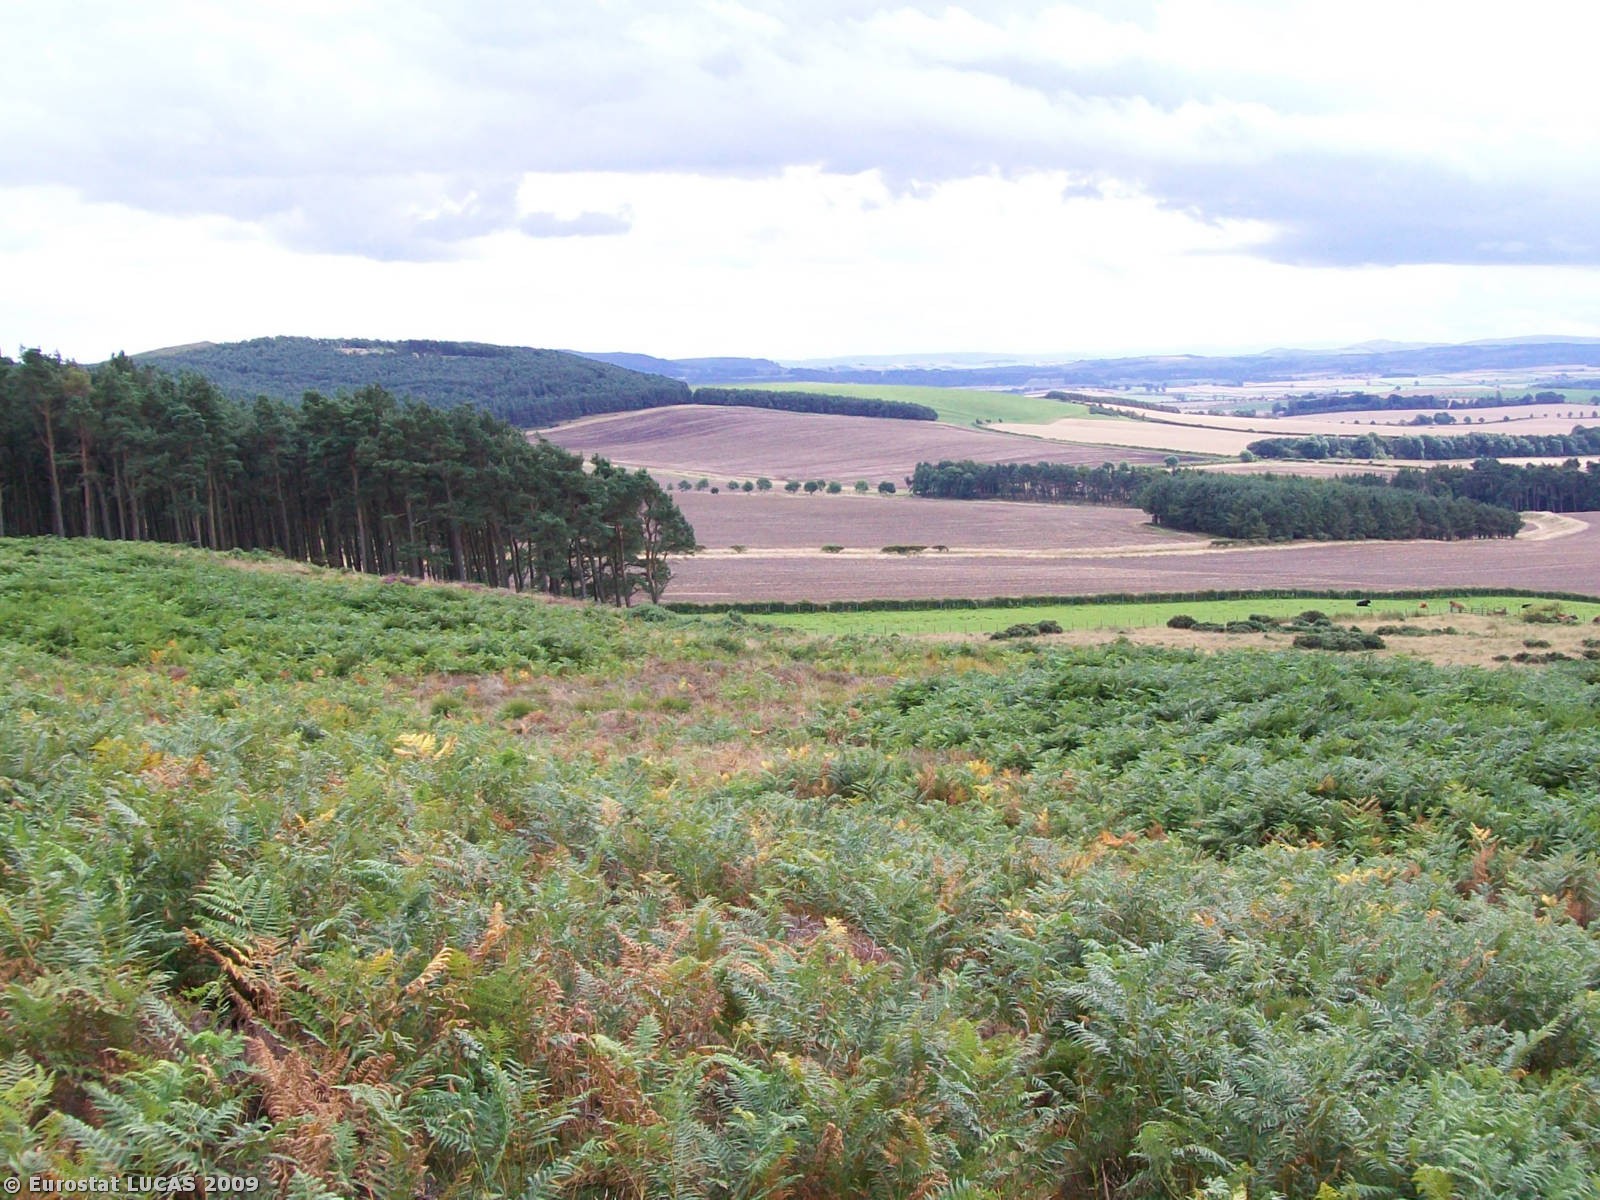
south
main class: Shrubland
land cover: Shrubland without tree cover
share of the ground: > 75 %
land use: Agriculture (excluding fallow land and kitchen gardens)
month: August
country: GB
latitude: 55.6125
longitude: -1.9107
